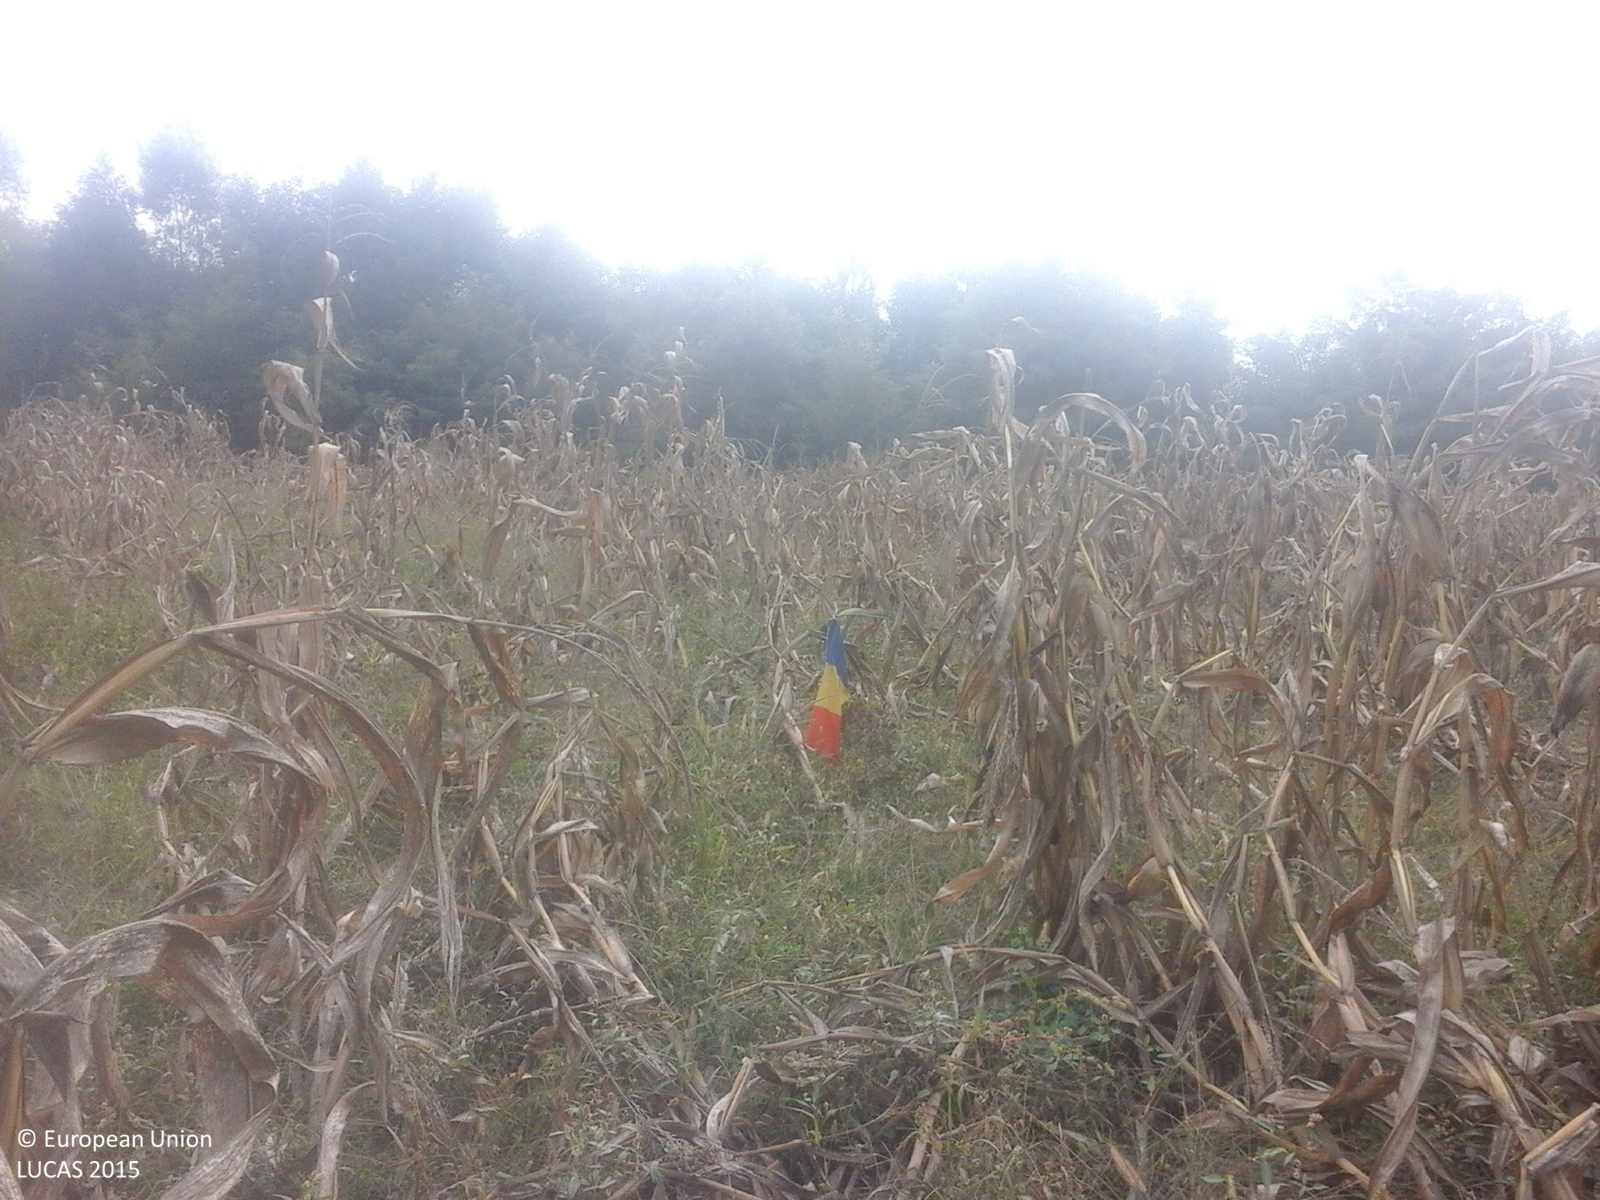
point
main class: Cropland
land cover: Maize
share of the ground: > 75 %
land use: Agriculture (excluding fallow land and kitchen gardens)
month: September
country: RO
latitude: 45.8665
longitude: 22.2167
